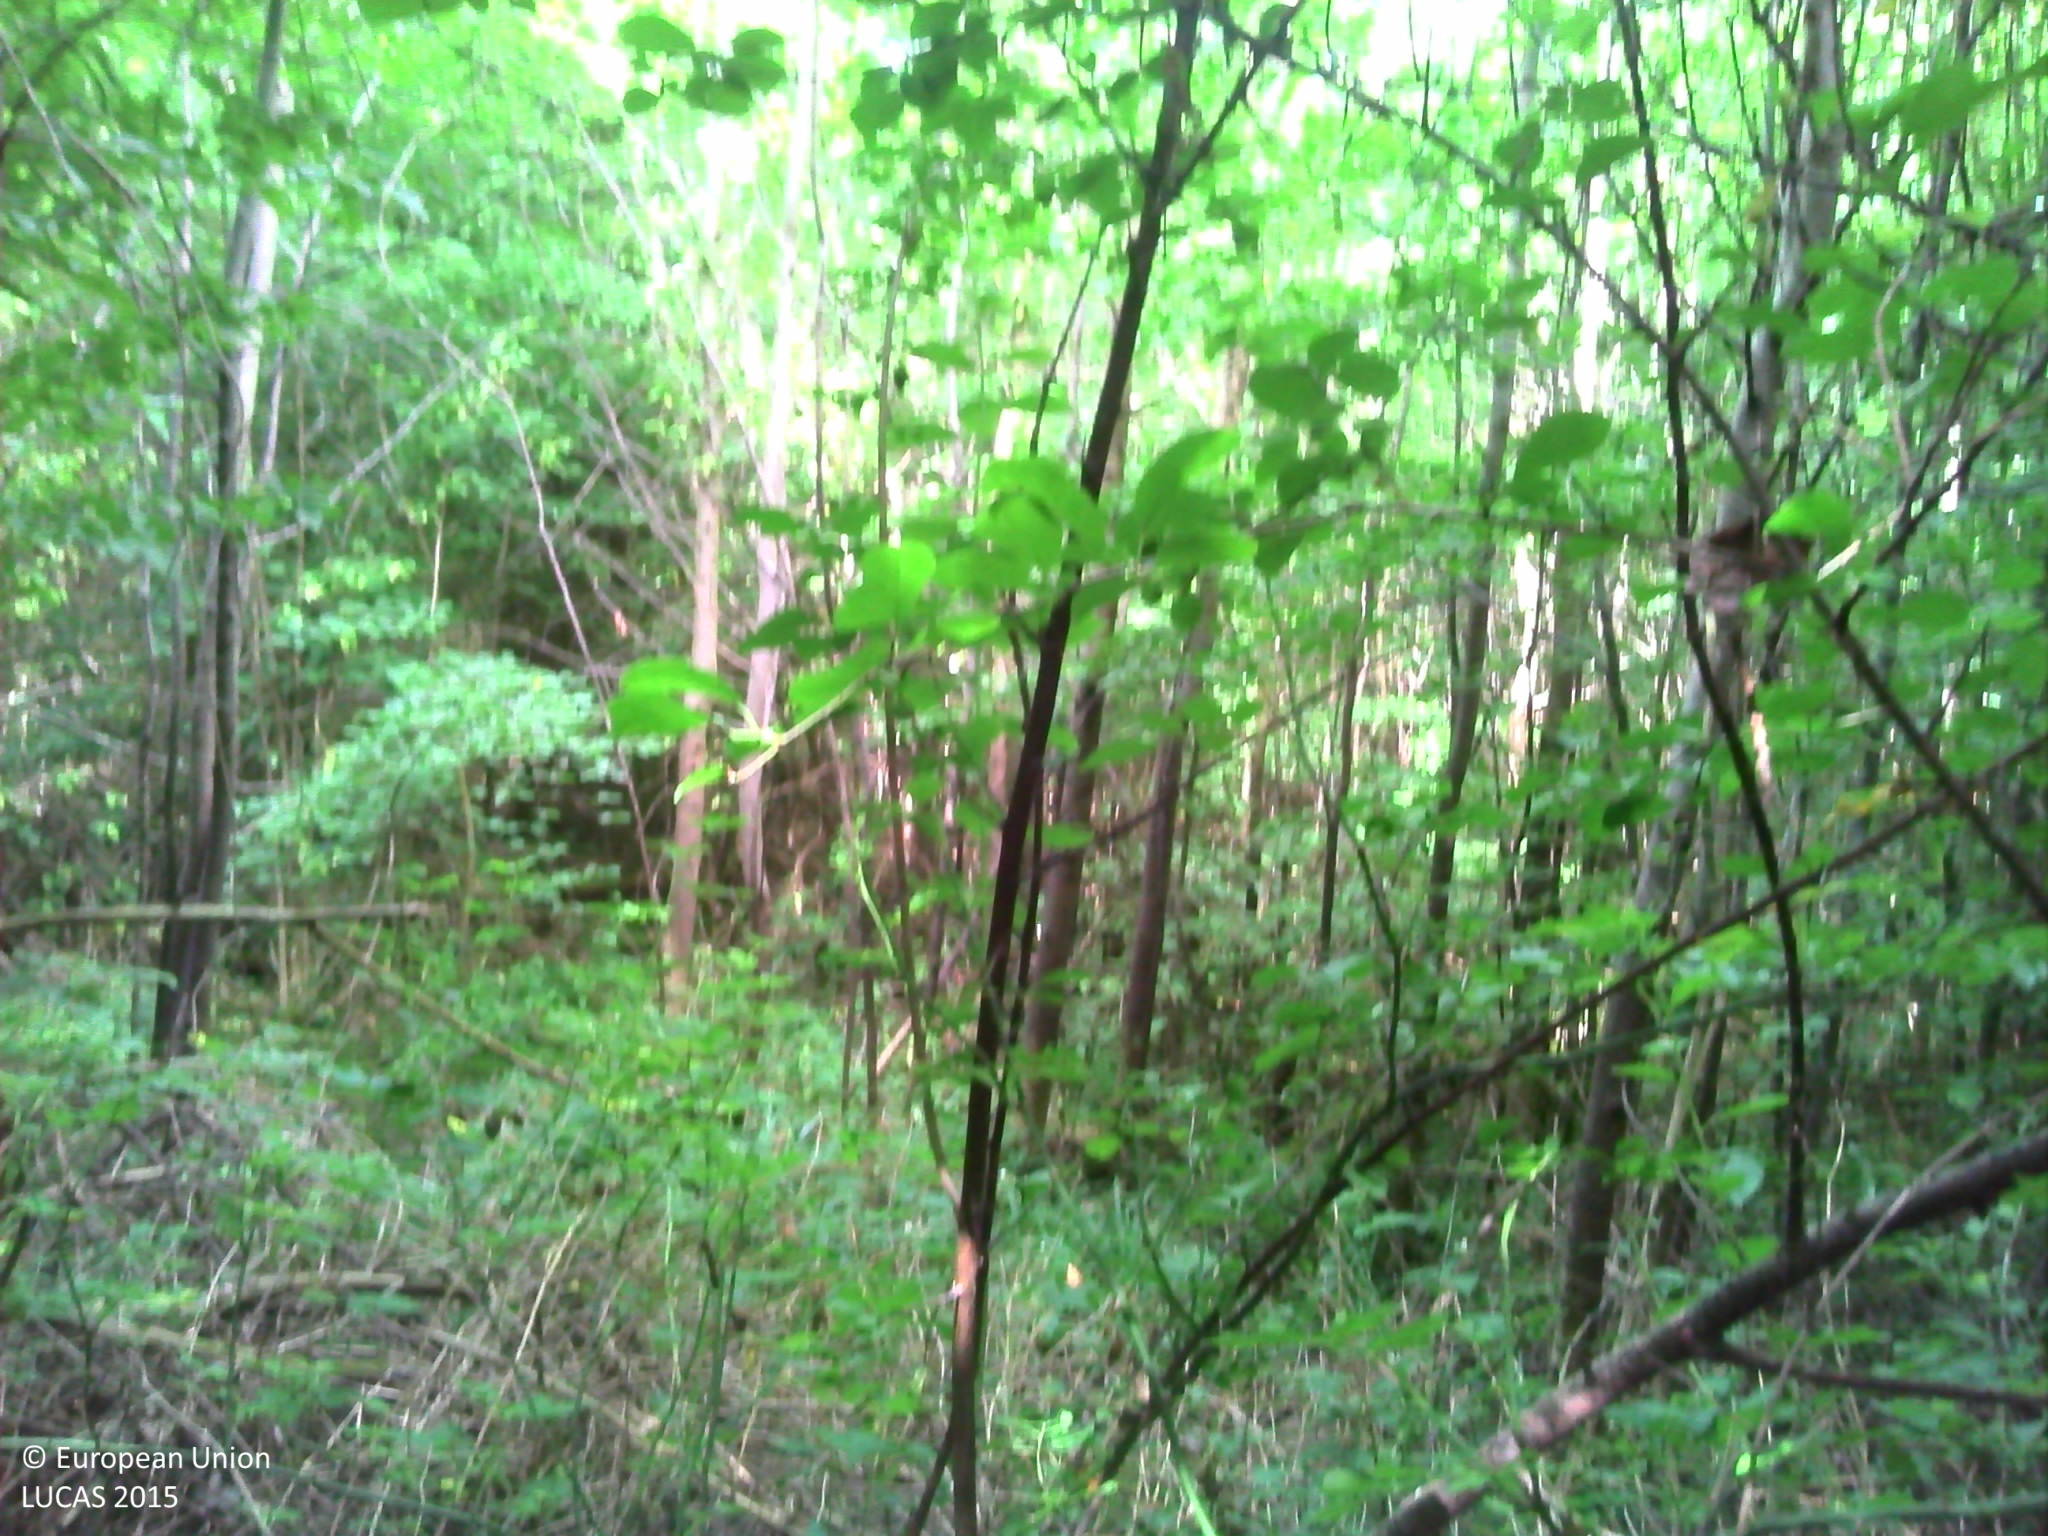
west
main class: Woodland
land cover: Broadleaved woodland
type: mesophytic deciduous forest
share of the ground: > 75 %
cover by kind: broadleaved forest trees 95 %, shrubs 5 %
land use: Forestry
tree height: > 5 m
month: June
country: FR
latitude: 48.8120
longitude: 4.9731
